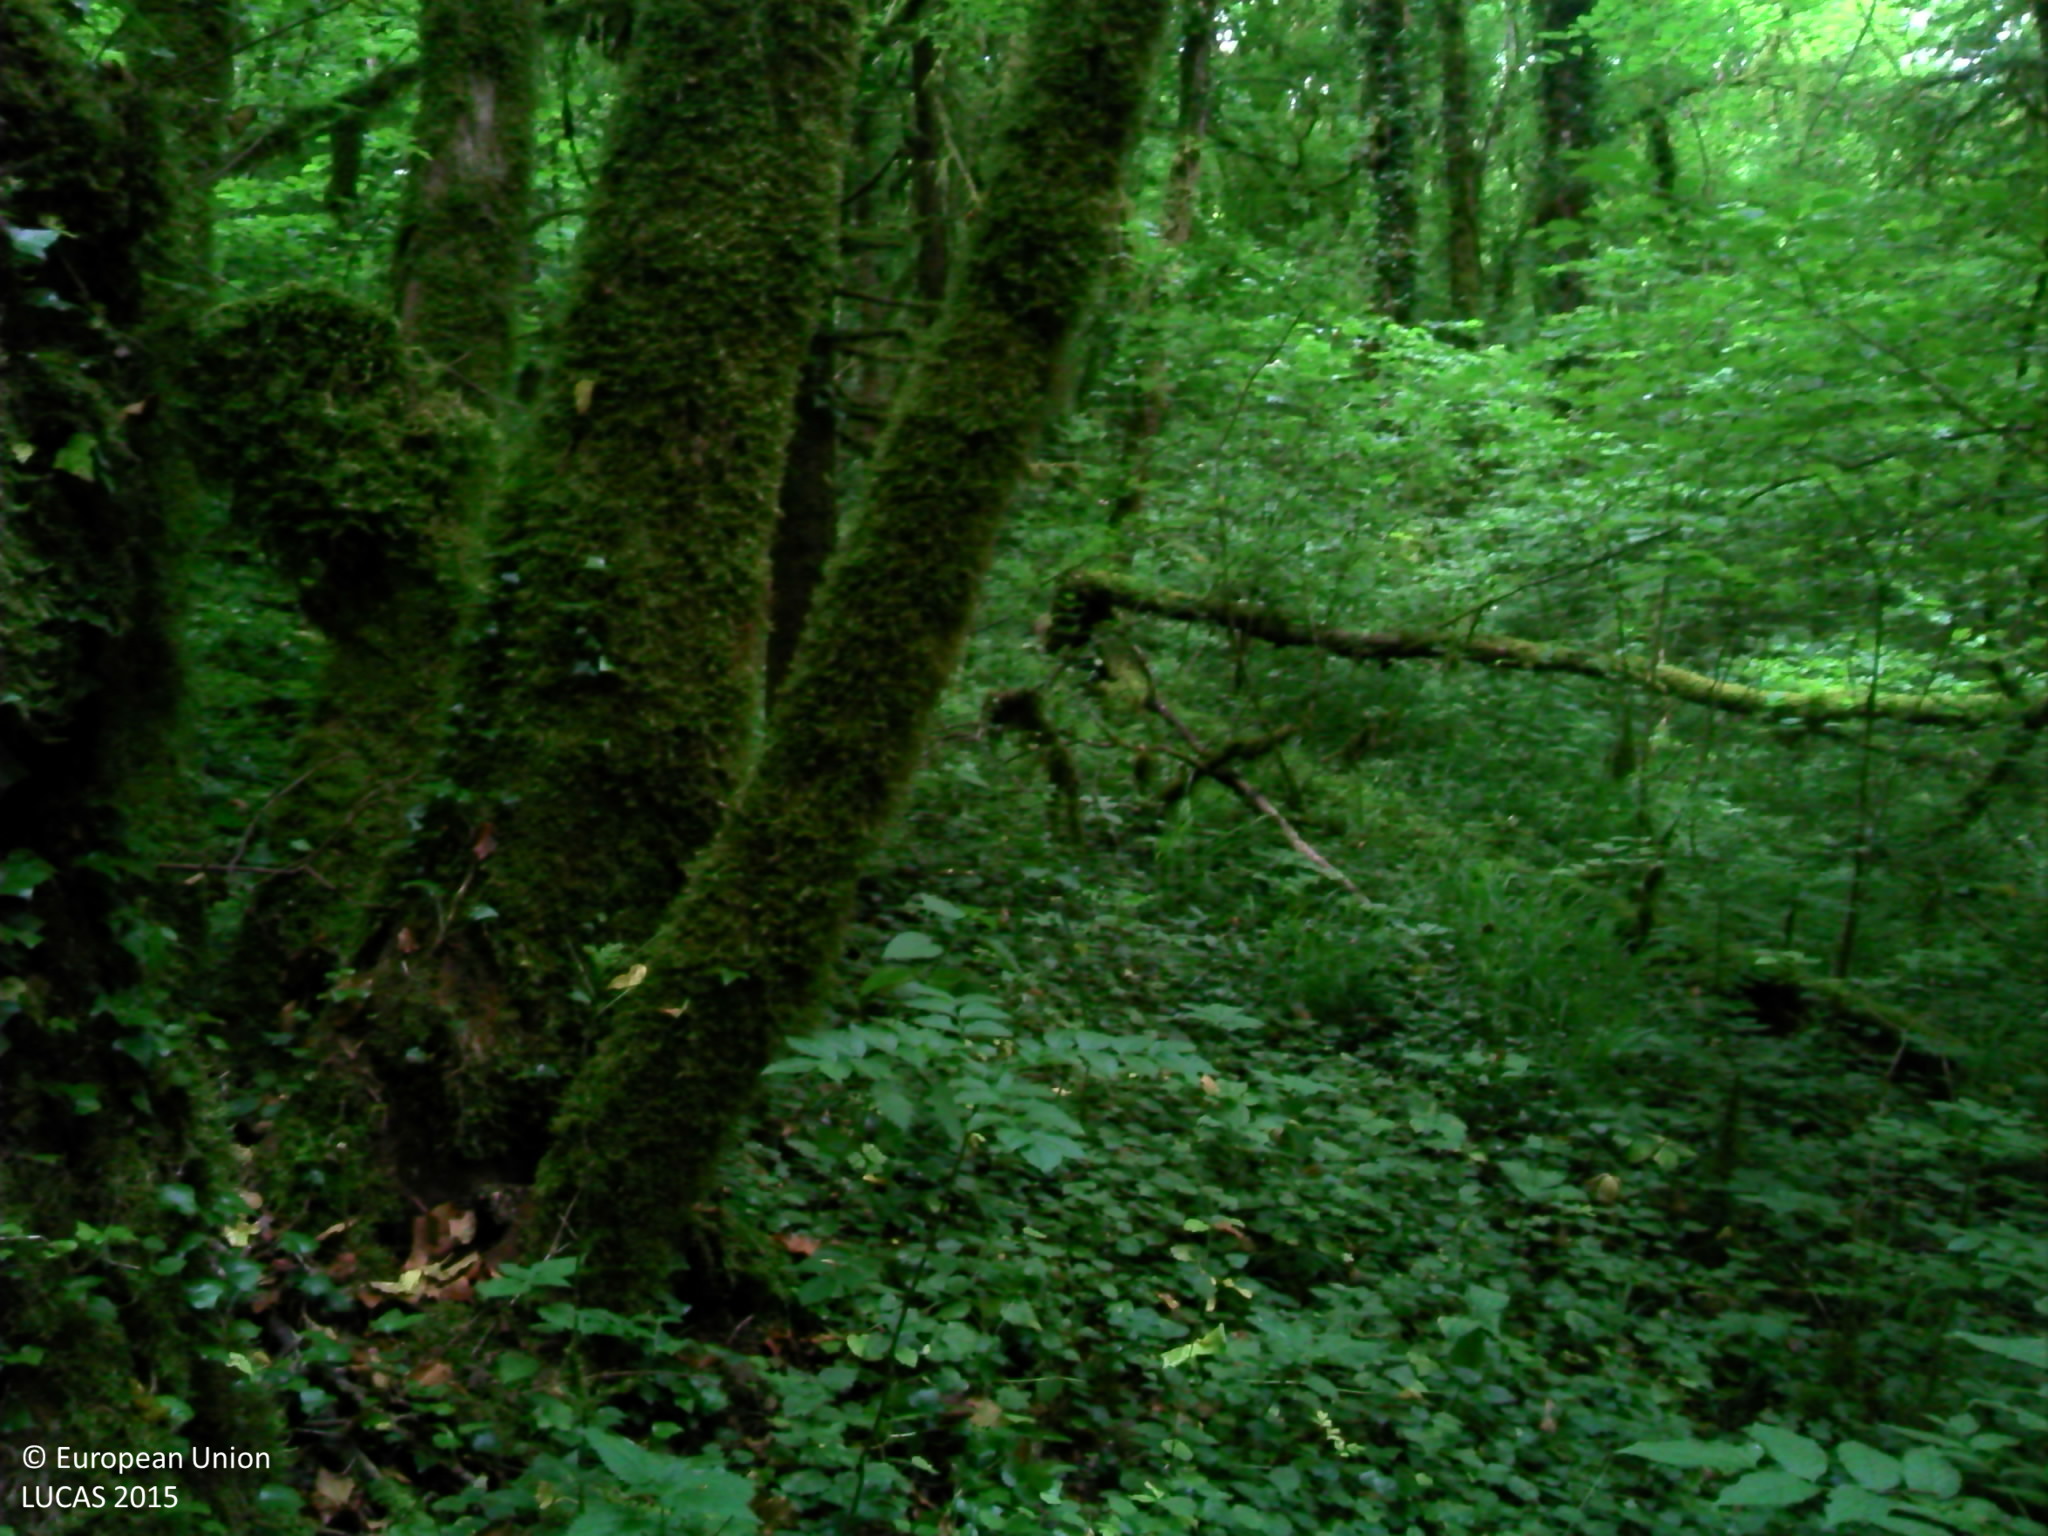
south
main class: Woodland
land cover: Broadleaved woodland
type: beech forest
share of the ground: > 75 %
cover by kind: broadleaved forest trees 90 %, herbaceous plants 10 %
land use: Forestry
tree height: > 5 m
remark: Harvested field
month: June
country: FR
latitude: 47.7285
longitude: 6.2813
